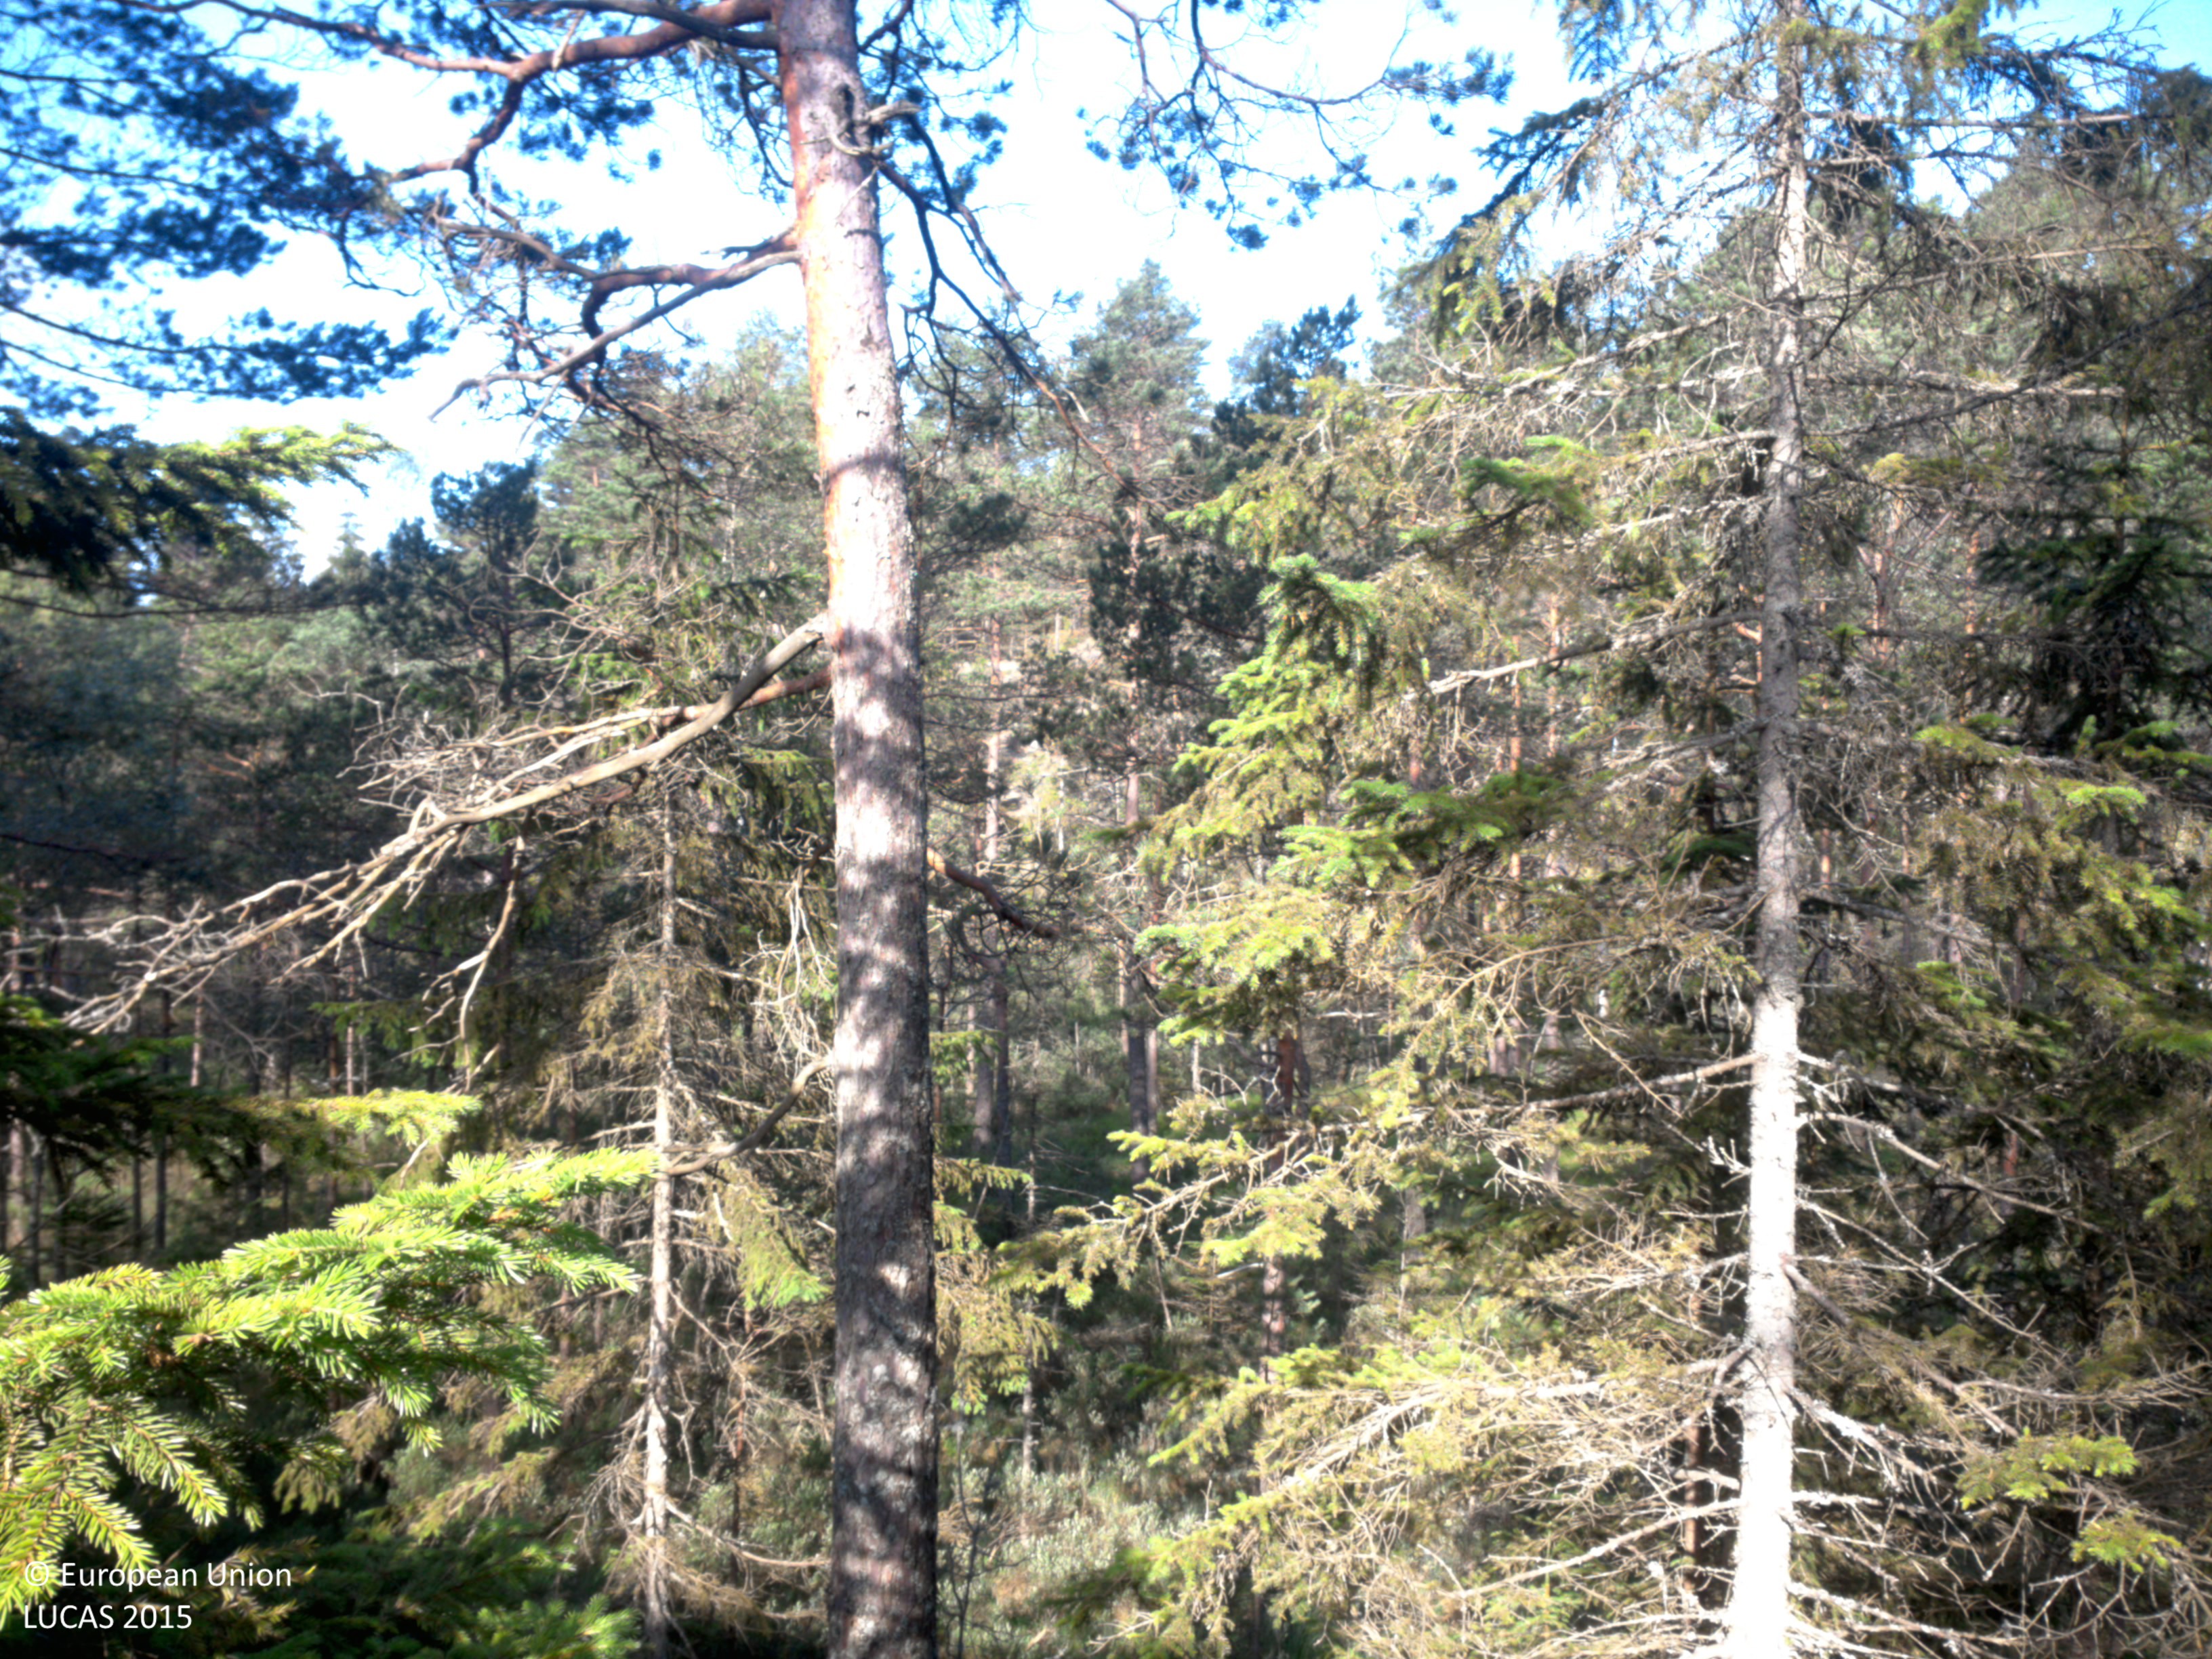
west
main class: Woodland
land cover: Pine dominated coniferous woodland
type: boreal forest
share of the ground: 25 - 50 %
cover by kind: coniferous forest trees 40 %, shrubs 30 %, lichens and mosses 30 %
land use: Forestry
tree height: > 5 m
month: July
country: SE
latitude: 58.8370
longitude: 11.8150
